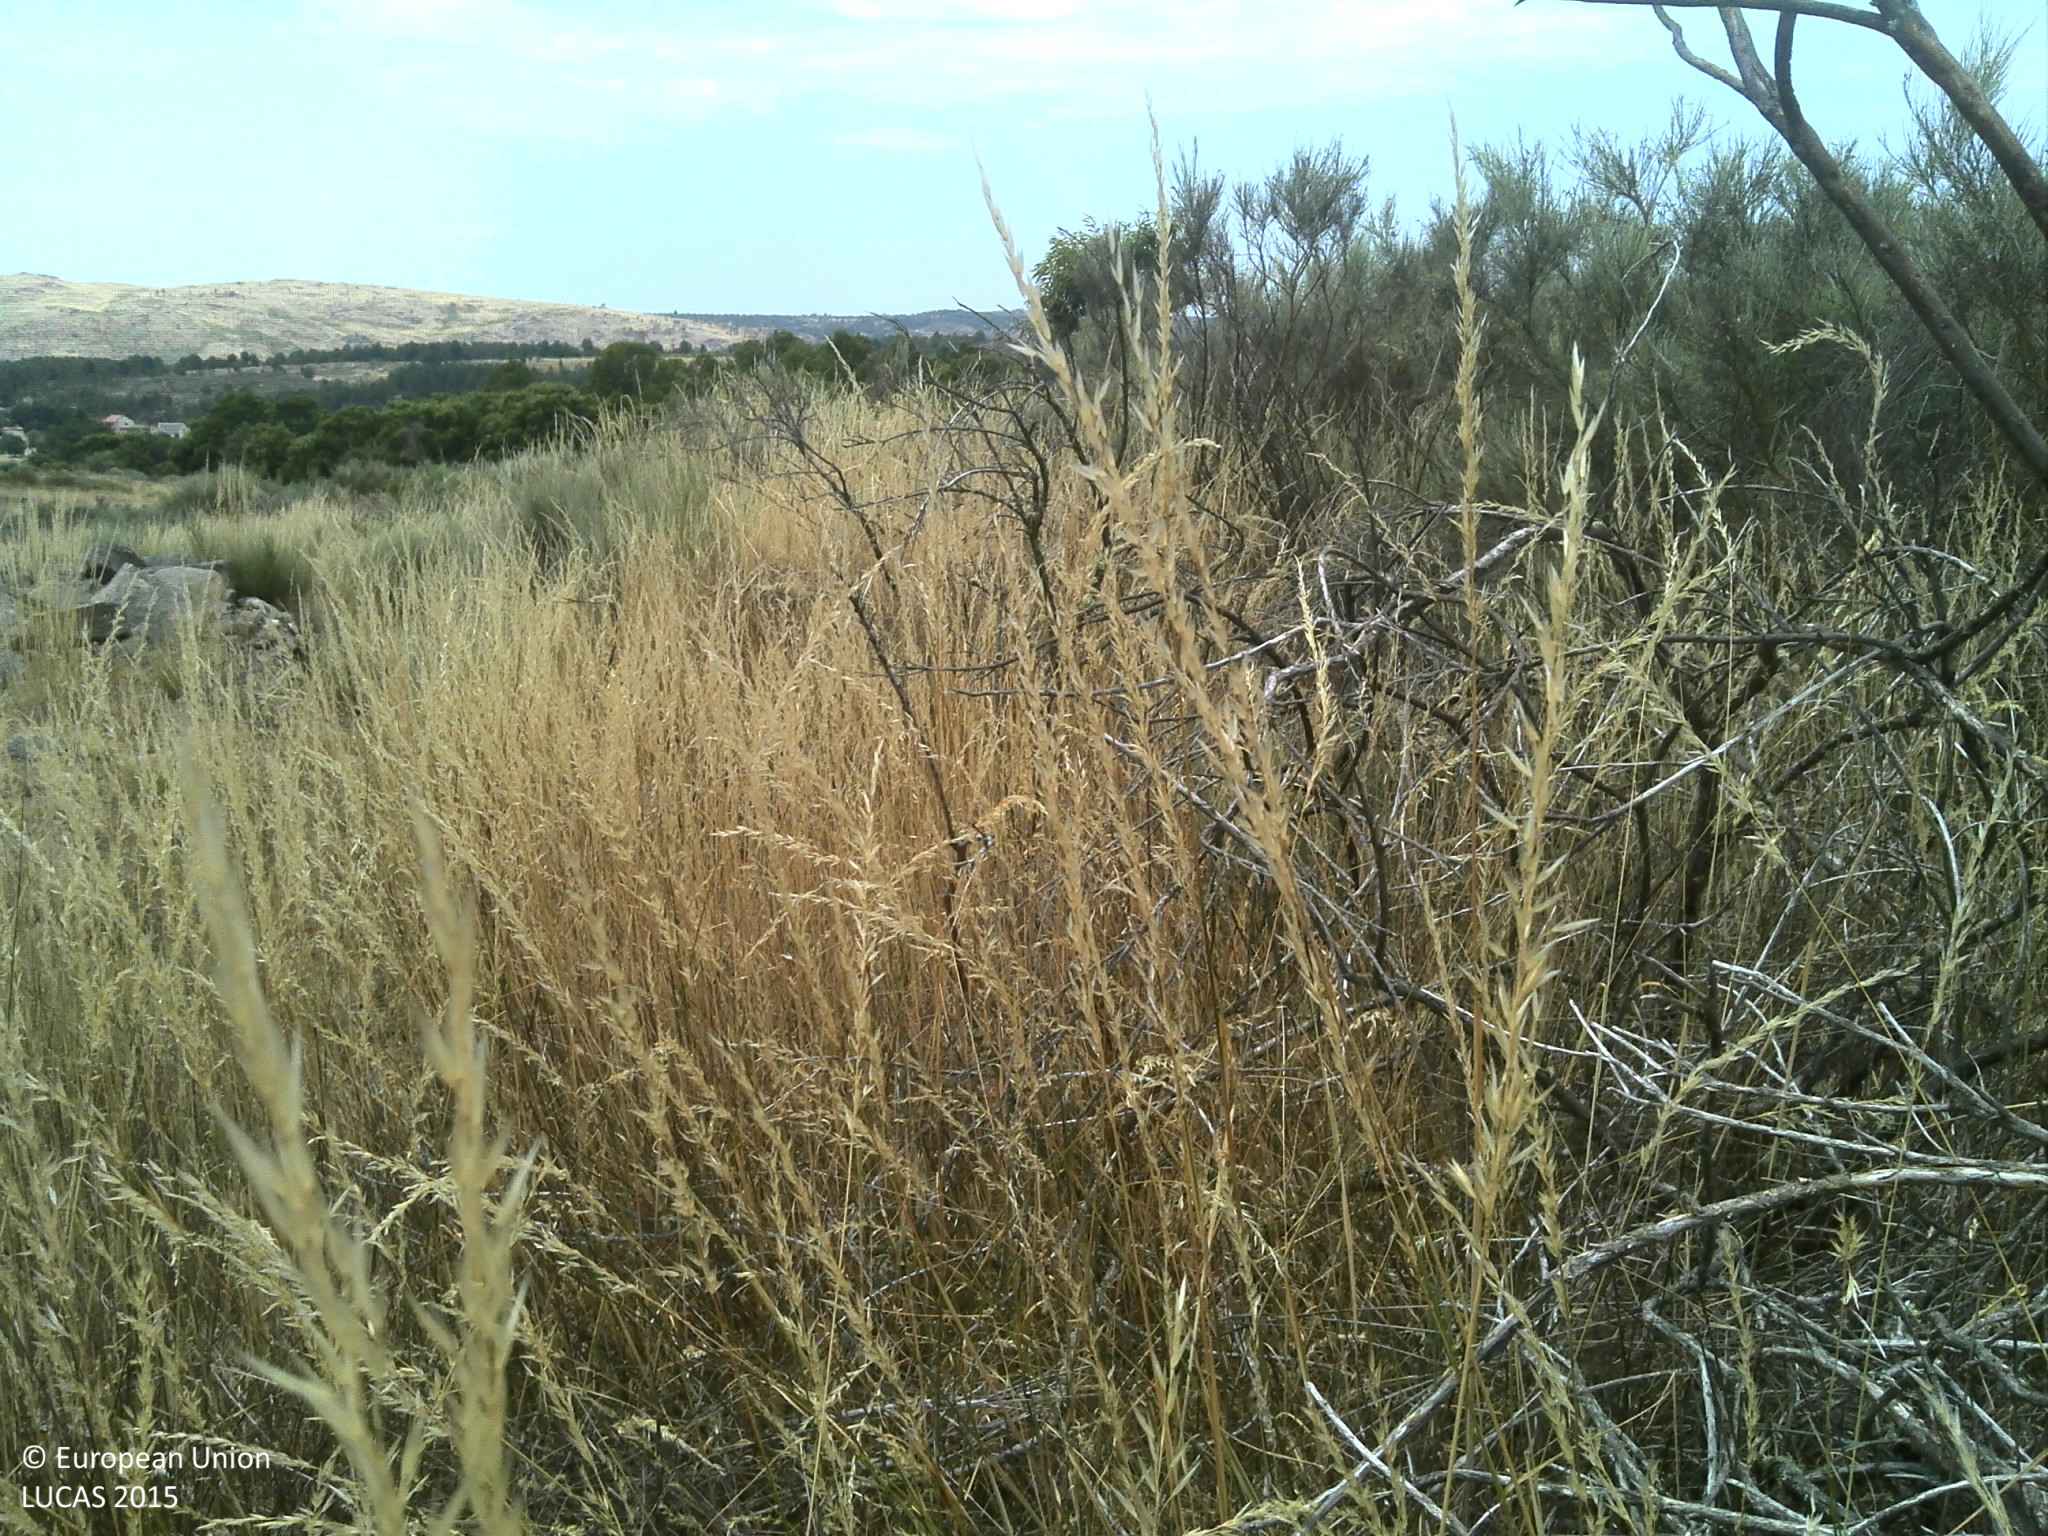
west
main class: Shrubland
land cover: Shrubland with sparse tree cover
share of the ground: 50 - 75 %
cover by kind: shrubs 65 %, herbaceous plants 15 %, unconsolidated bare surface 10 %, coniferous forest trees 5 %, consolidated bare surface 5 %
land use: Semi-natural and natural areas not in use
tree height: > 5 m
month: July
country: PT
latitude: 41.0107
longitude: -7.3691
